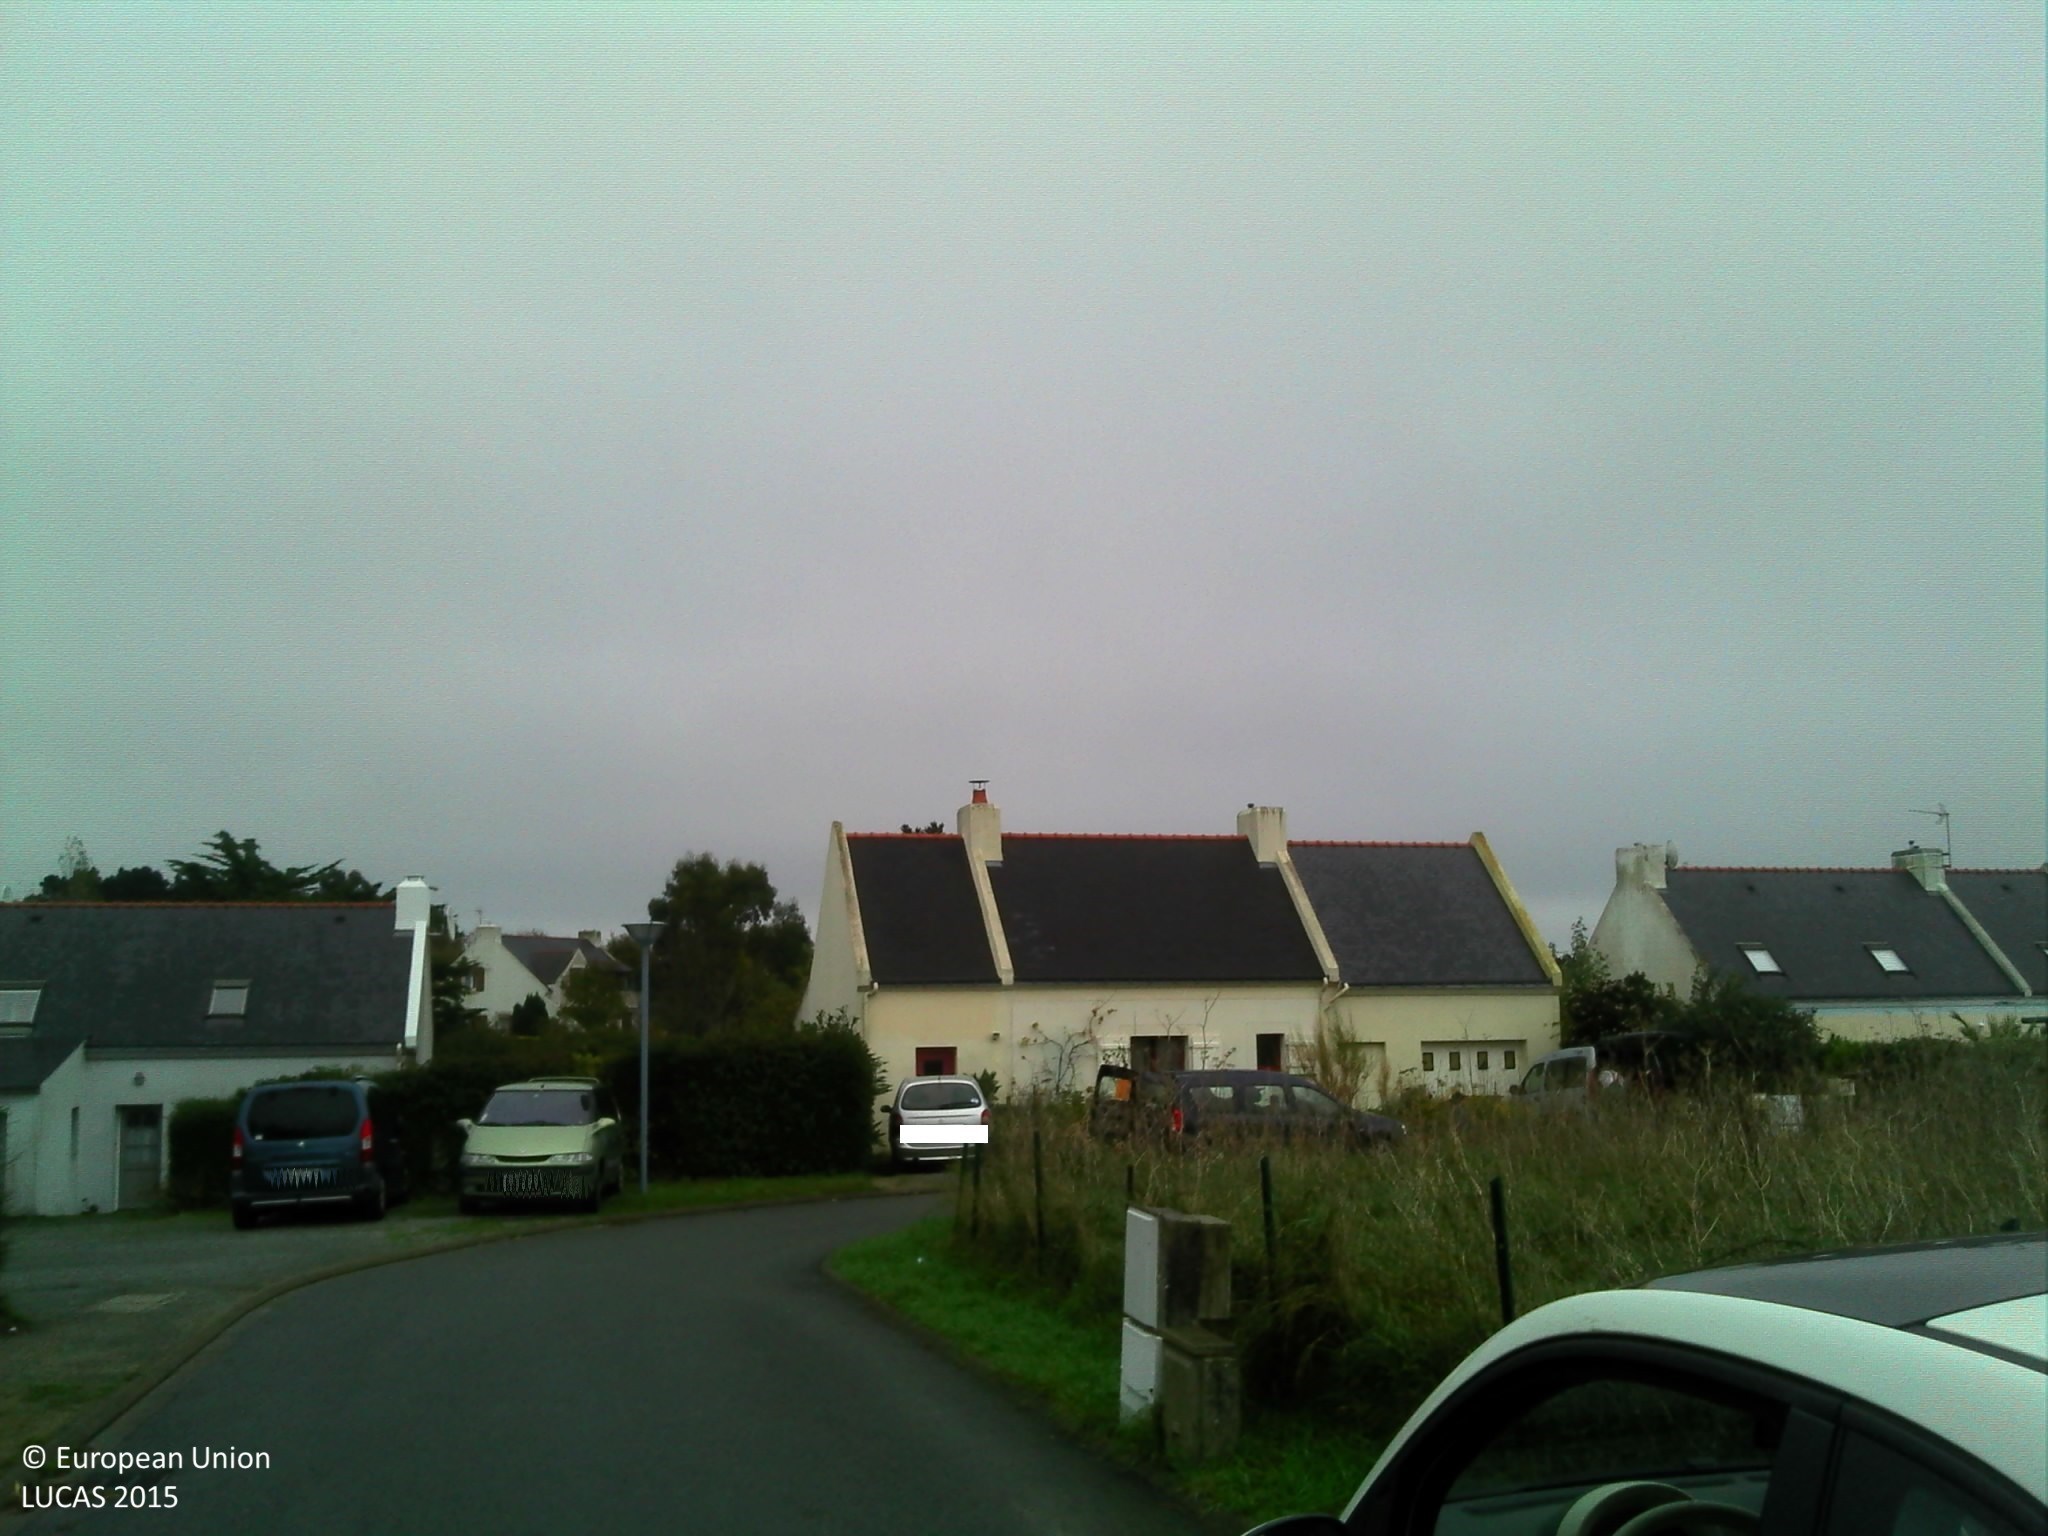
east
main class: Grassland
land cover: Grassland without tree/shrub cover
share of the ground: > 75 %
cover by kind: herbaceous plants 100 %
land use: Residential
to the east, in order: Grassland without tree/shrub cover; Artificial constructions in urban areas; Broadleaved woodland; Artificial constructions in urban areas; Broadleaved woodland
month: November
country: FR
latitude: 47.3397
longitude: -3.1563
